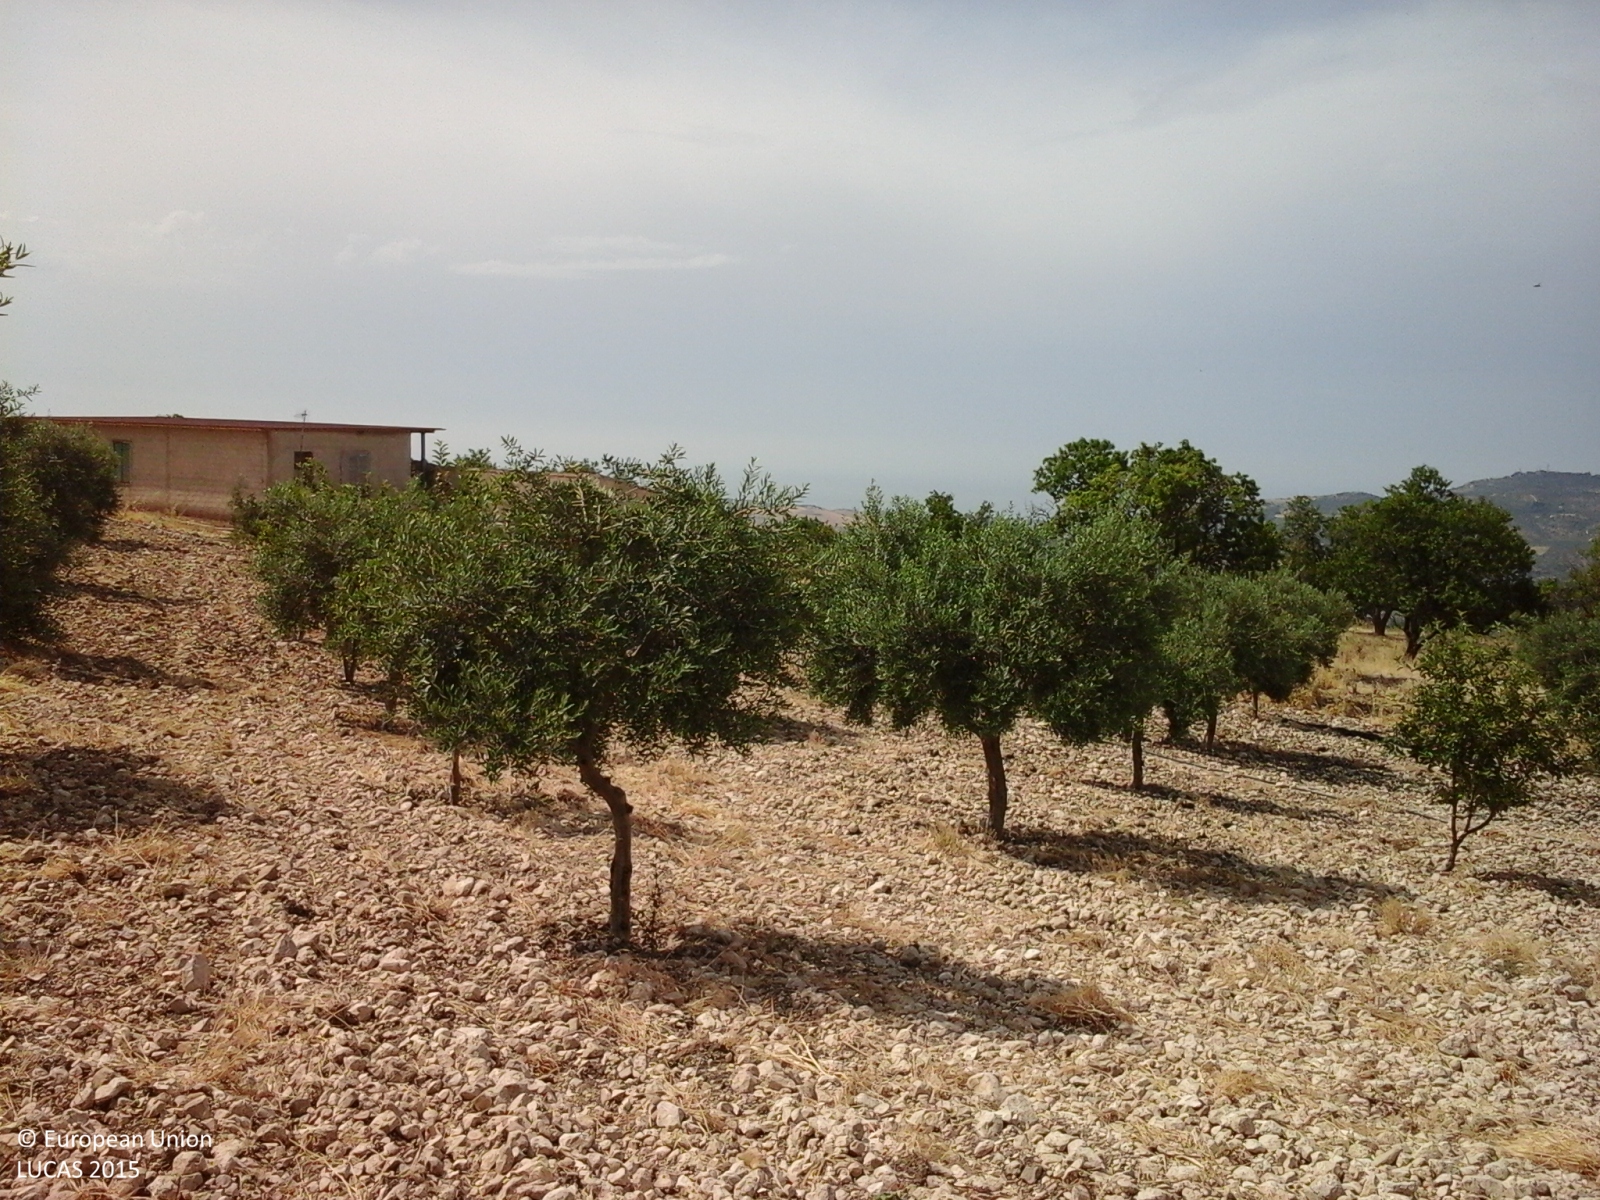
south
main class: Cropland
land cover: Olive groves
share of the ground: 25 - 50 %
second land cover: Other bare soil
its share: > 75 %
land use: Agriculture (excluding fallow land and kitchen gardens)
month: June
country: IT
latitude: 37.5687
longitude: 13.1349
